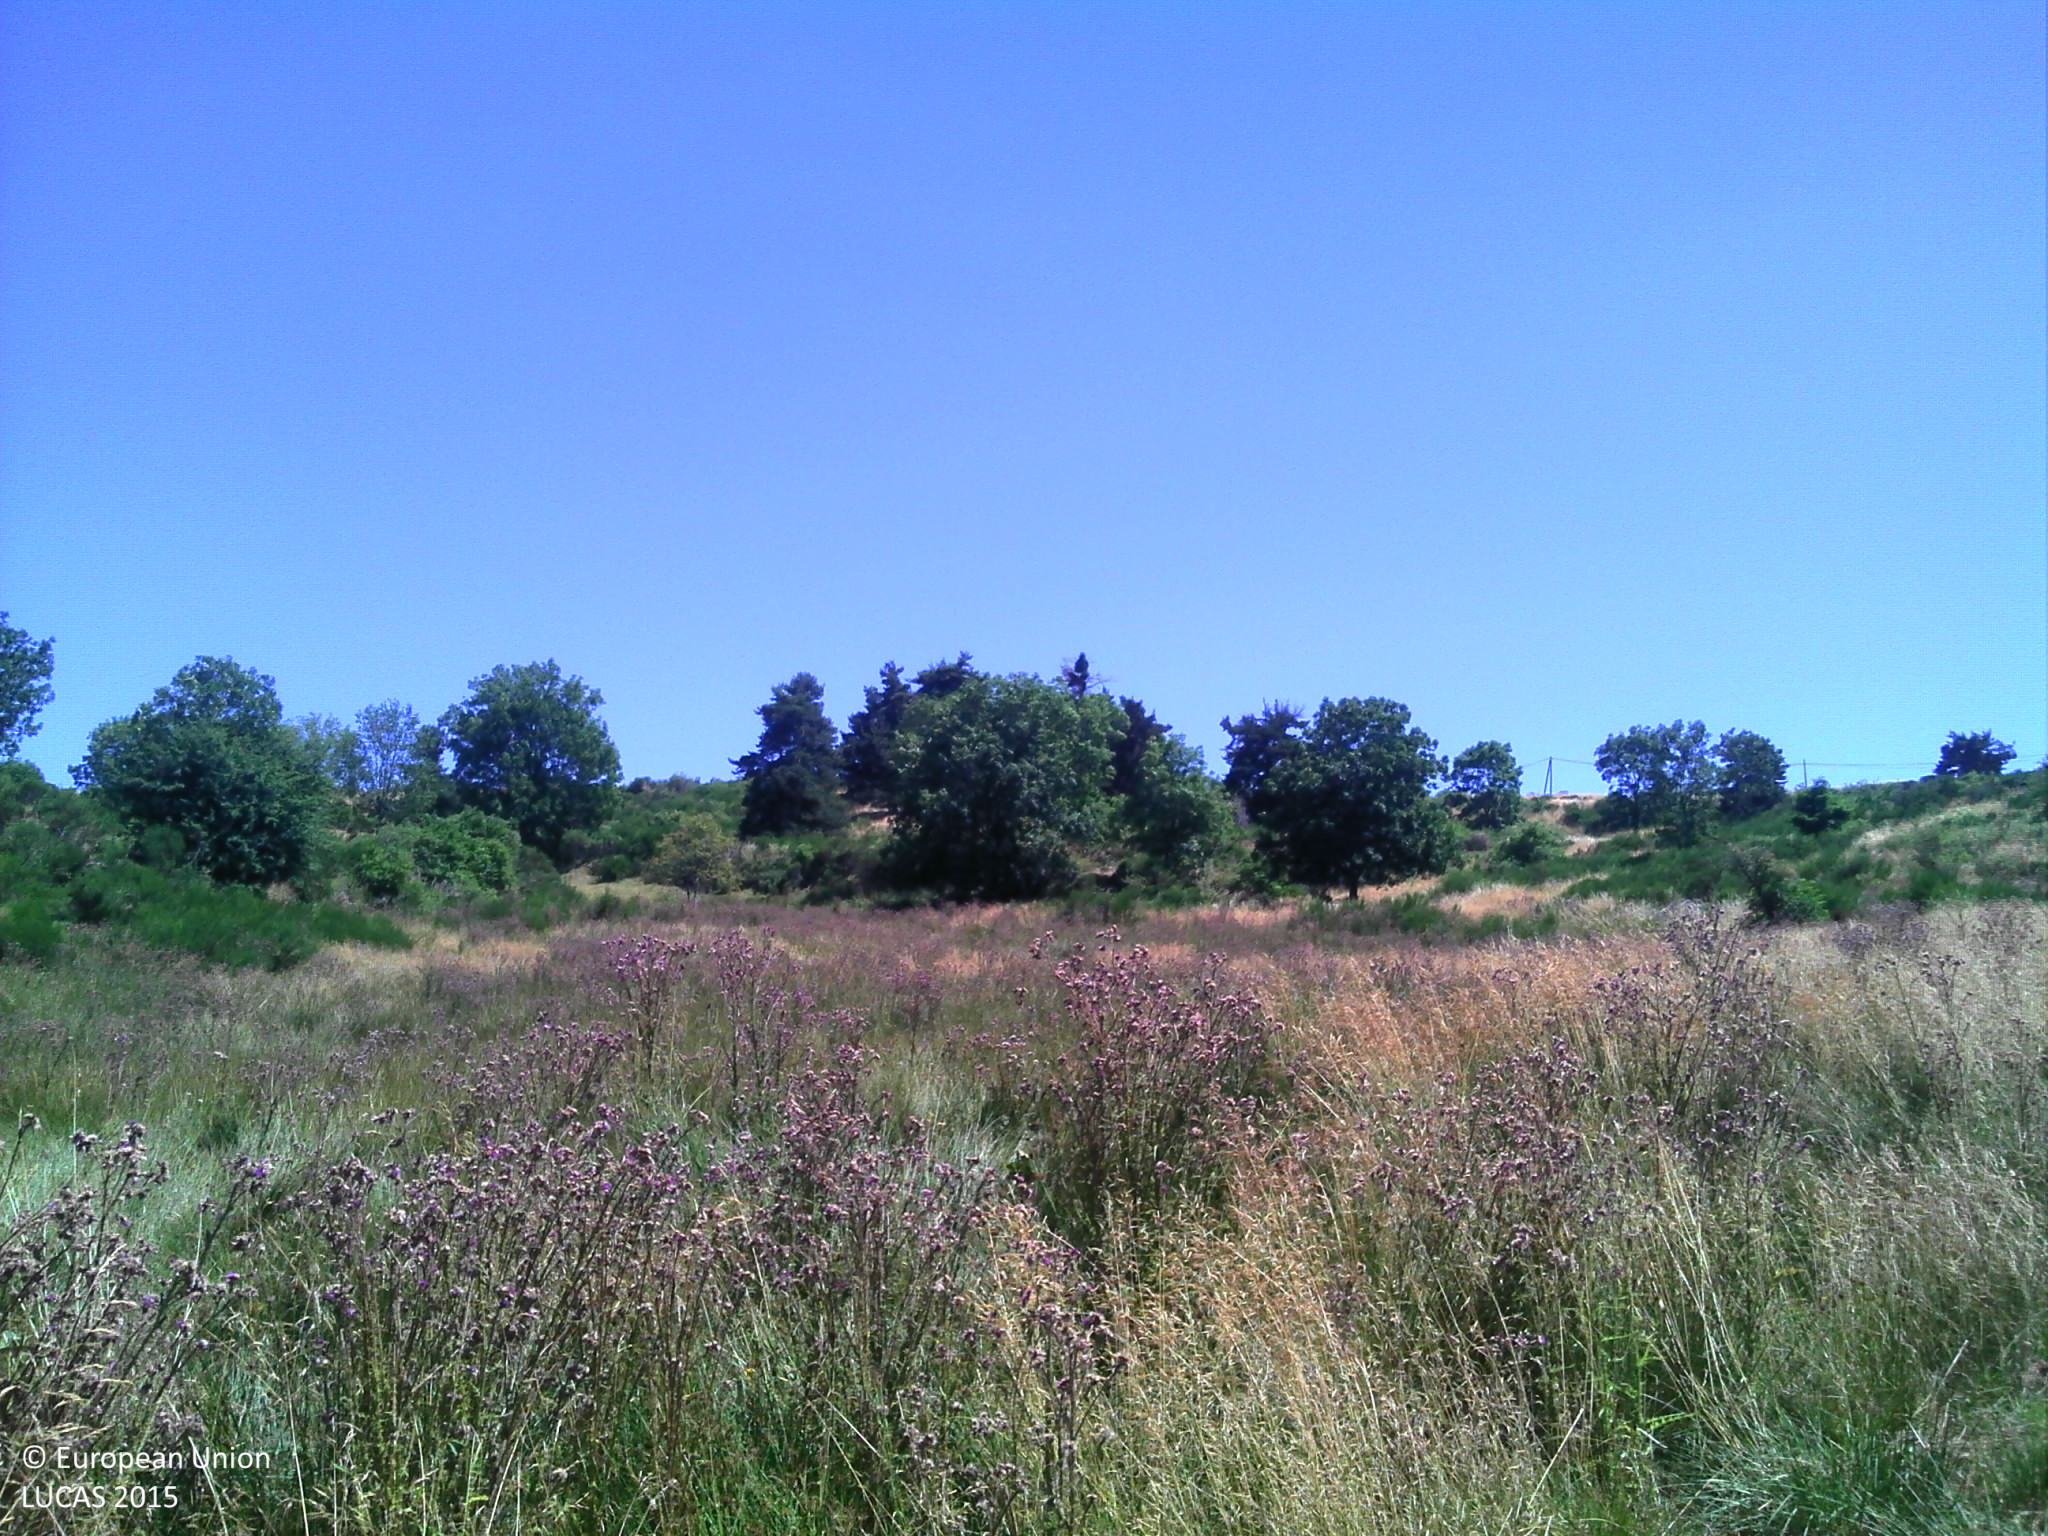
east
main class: Grassland
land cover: Grassland without tree/shrub cover
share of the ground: > 75 %
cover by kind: herbaceous plants 95 %, shrubs 5 %
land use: Agriculture (excluding fallow land and kitchen gardens)
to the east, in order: Grassland without tree/shrub cover; Rivers and streams; Grassland without tree/shrub cover; Fences; Broadleaved woodland; Shrubland without tree cover; Fences; Grassland without tree/shrub cover; Lines of trees; Grassland without tree/shrub cover
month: July
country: FR
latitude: 44.7404
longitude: 3.4498
